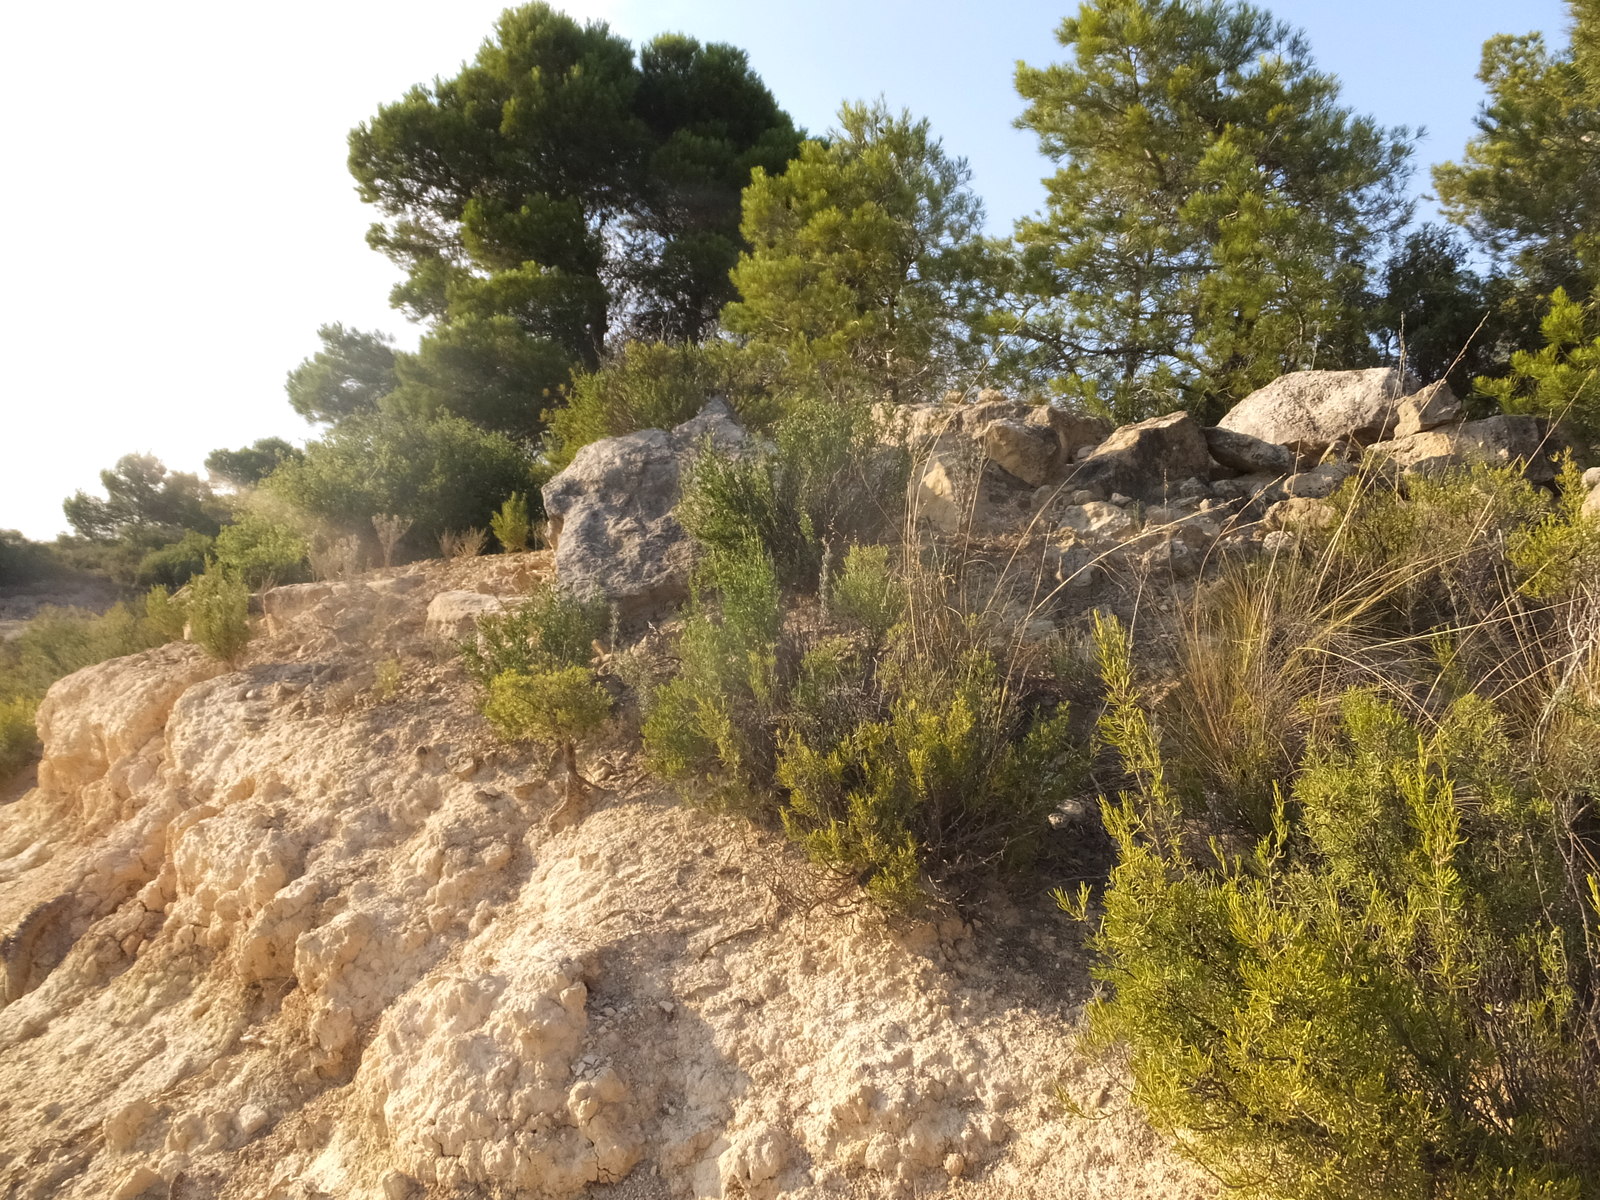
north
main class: Cropland
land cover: Nuts trees
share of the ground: 50 - 75 %
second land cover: Spontaneously vegetated surfaces
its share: < 10 %
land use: Agriculture (excluding fallow land and kitchen gardens)
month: July
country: ES
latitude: 41.0834
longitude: 0.1695
